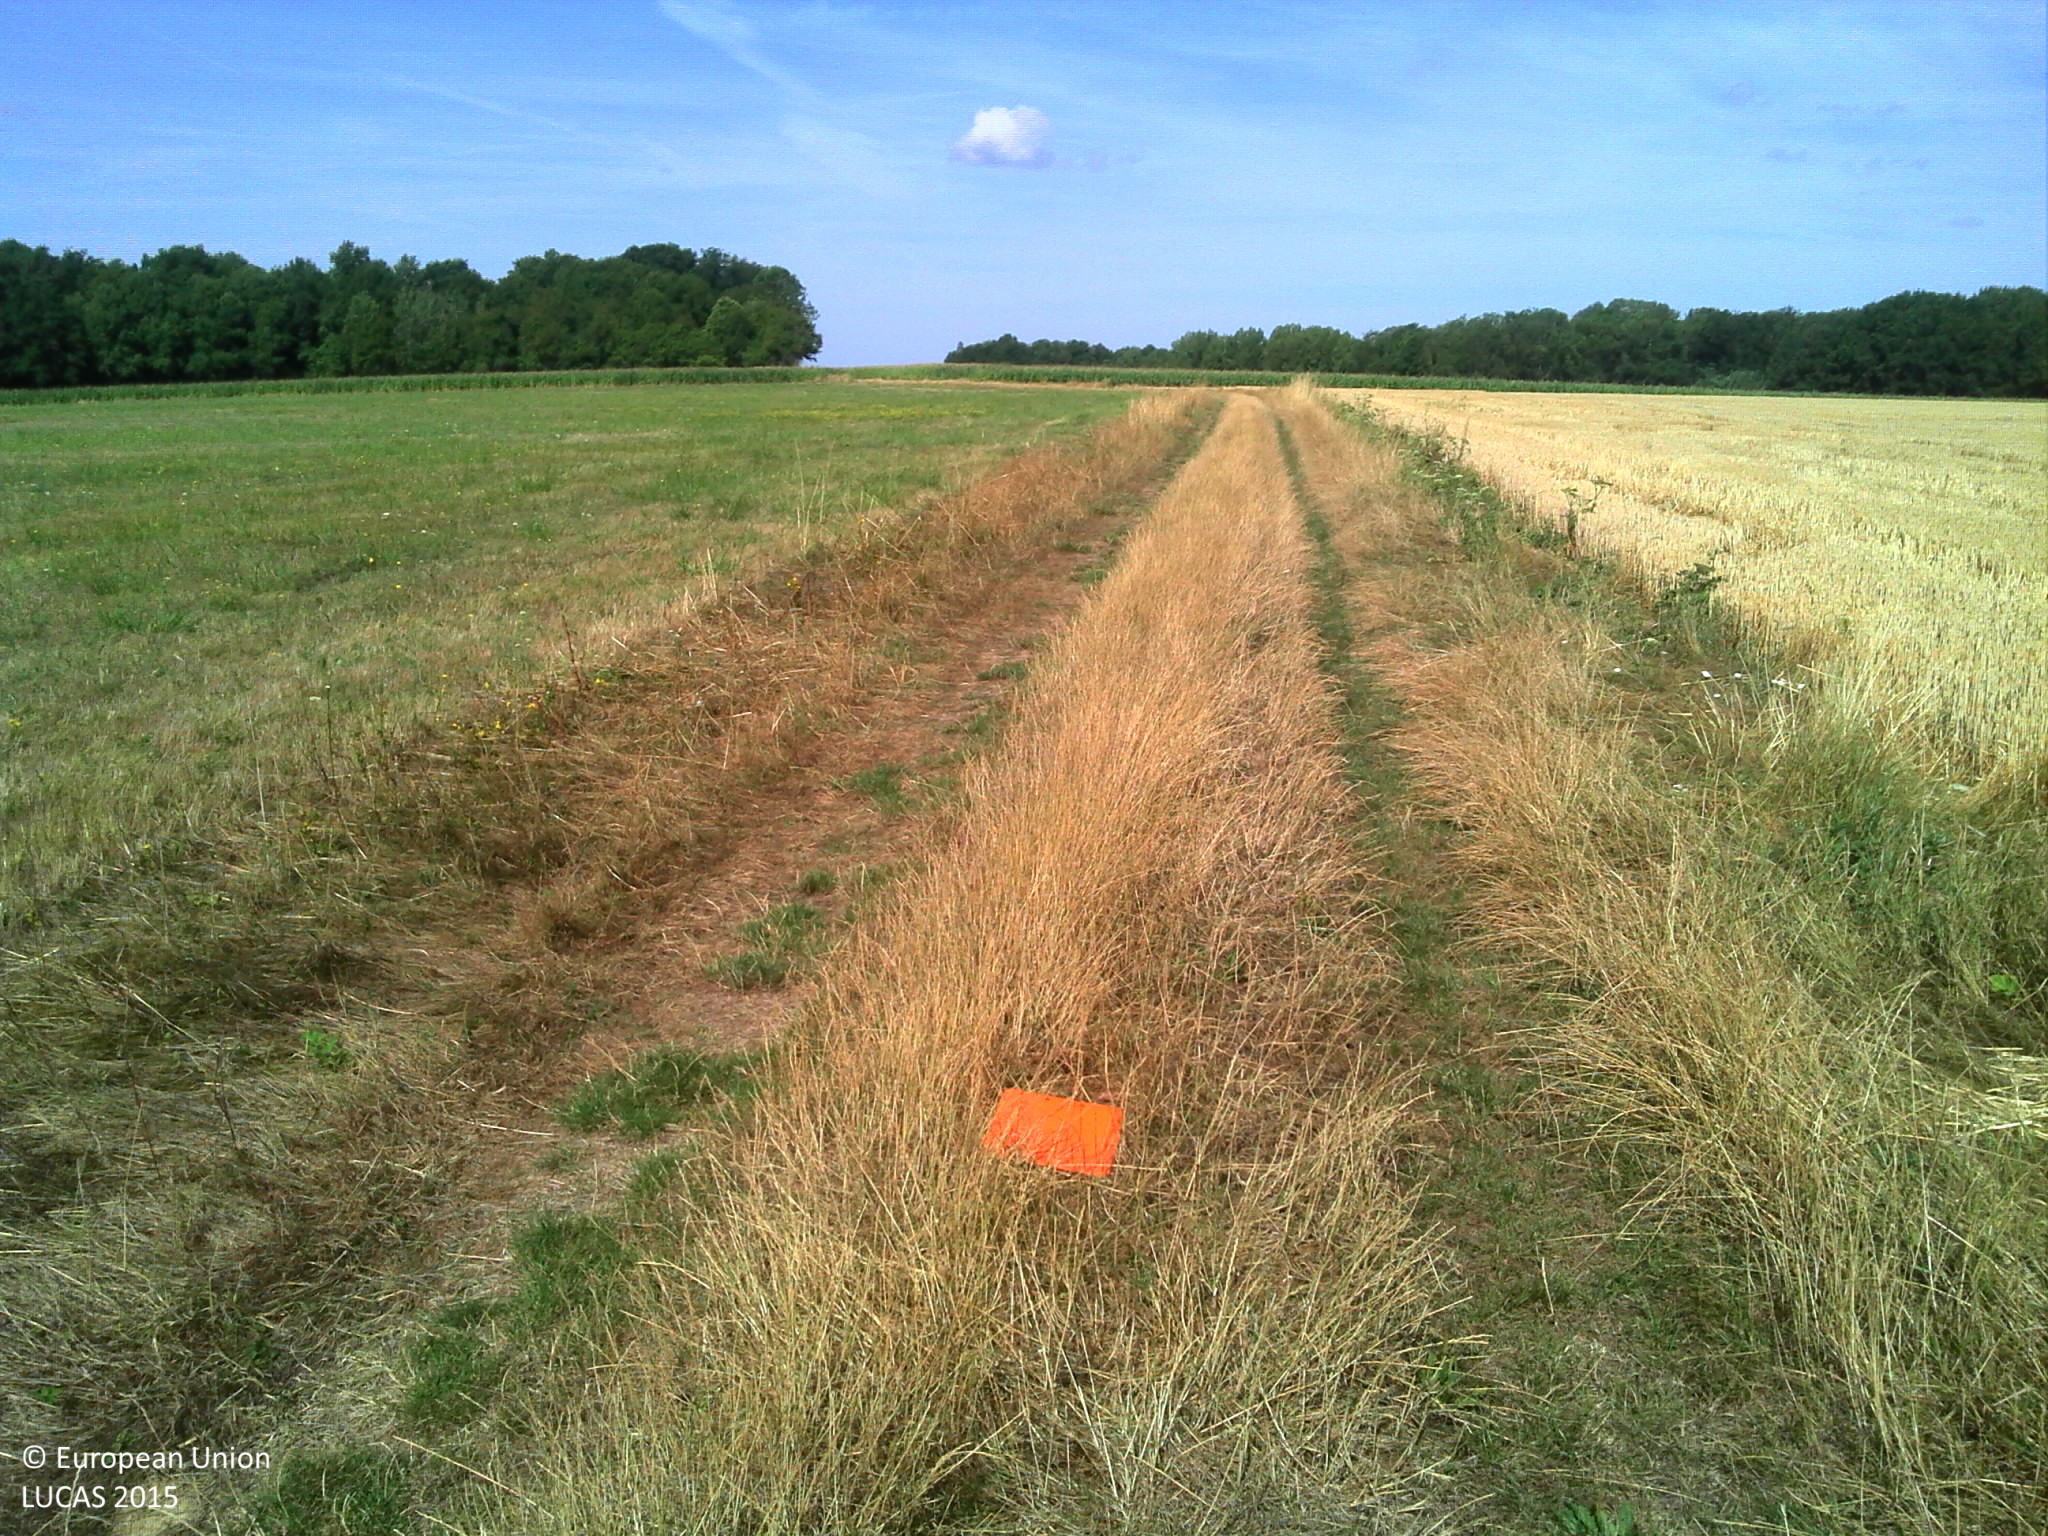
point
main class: Artificial land
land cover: Non built-up linear features
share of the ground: > 75 %
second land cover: Grassland without tree/shrub cover
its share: > 75 %
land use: Road transport
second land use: Agriculture (excluding fallow land and kitchen gardens)
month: August
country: FR
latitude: 48.7444
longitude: 3.3429
